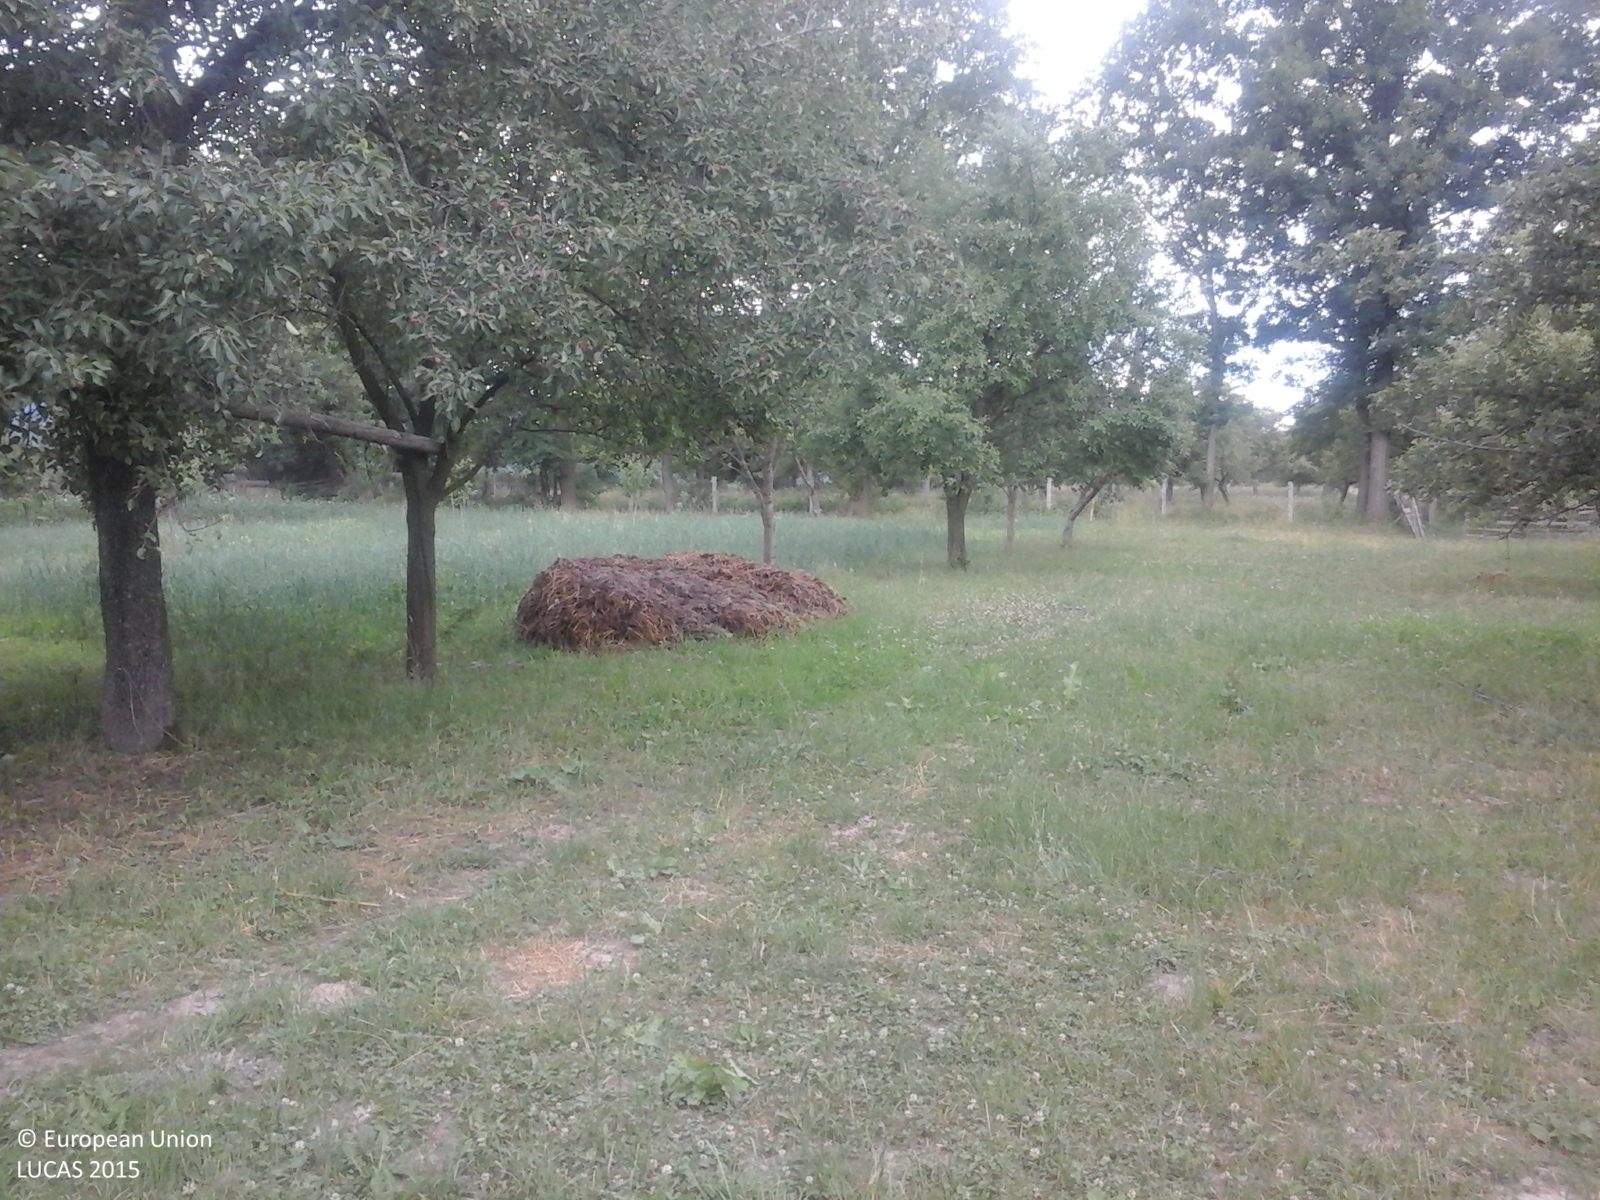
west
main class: Grassland
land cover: Grassland without tree/shrub cover
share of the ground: 50 - 75 %
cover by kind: herbaceous plants 100 %
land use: Agriculture (excluding fallow land and kitchen gardens)
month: June
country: RO
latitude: 47.6425
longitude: 25.9281
